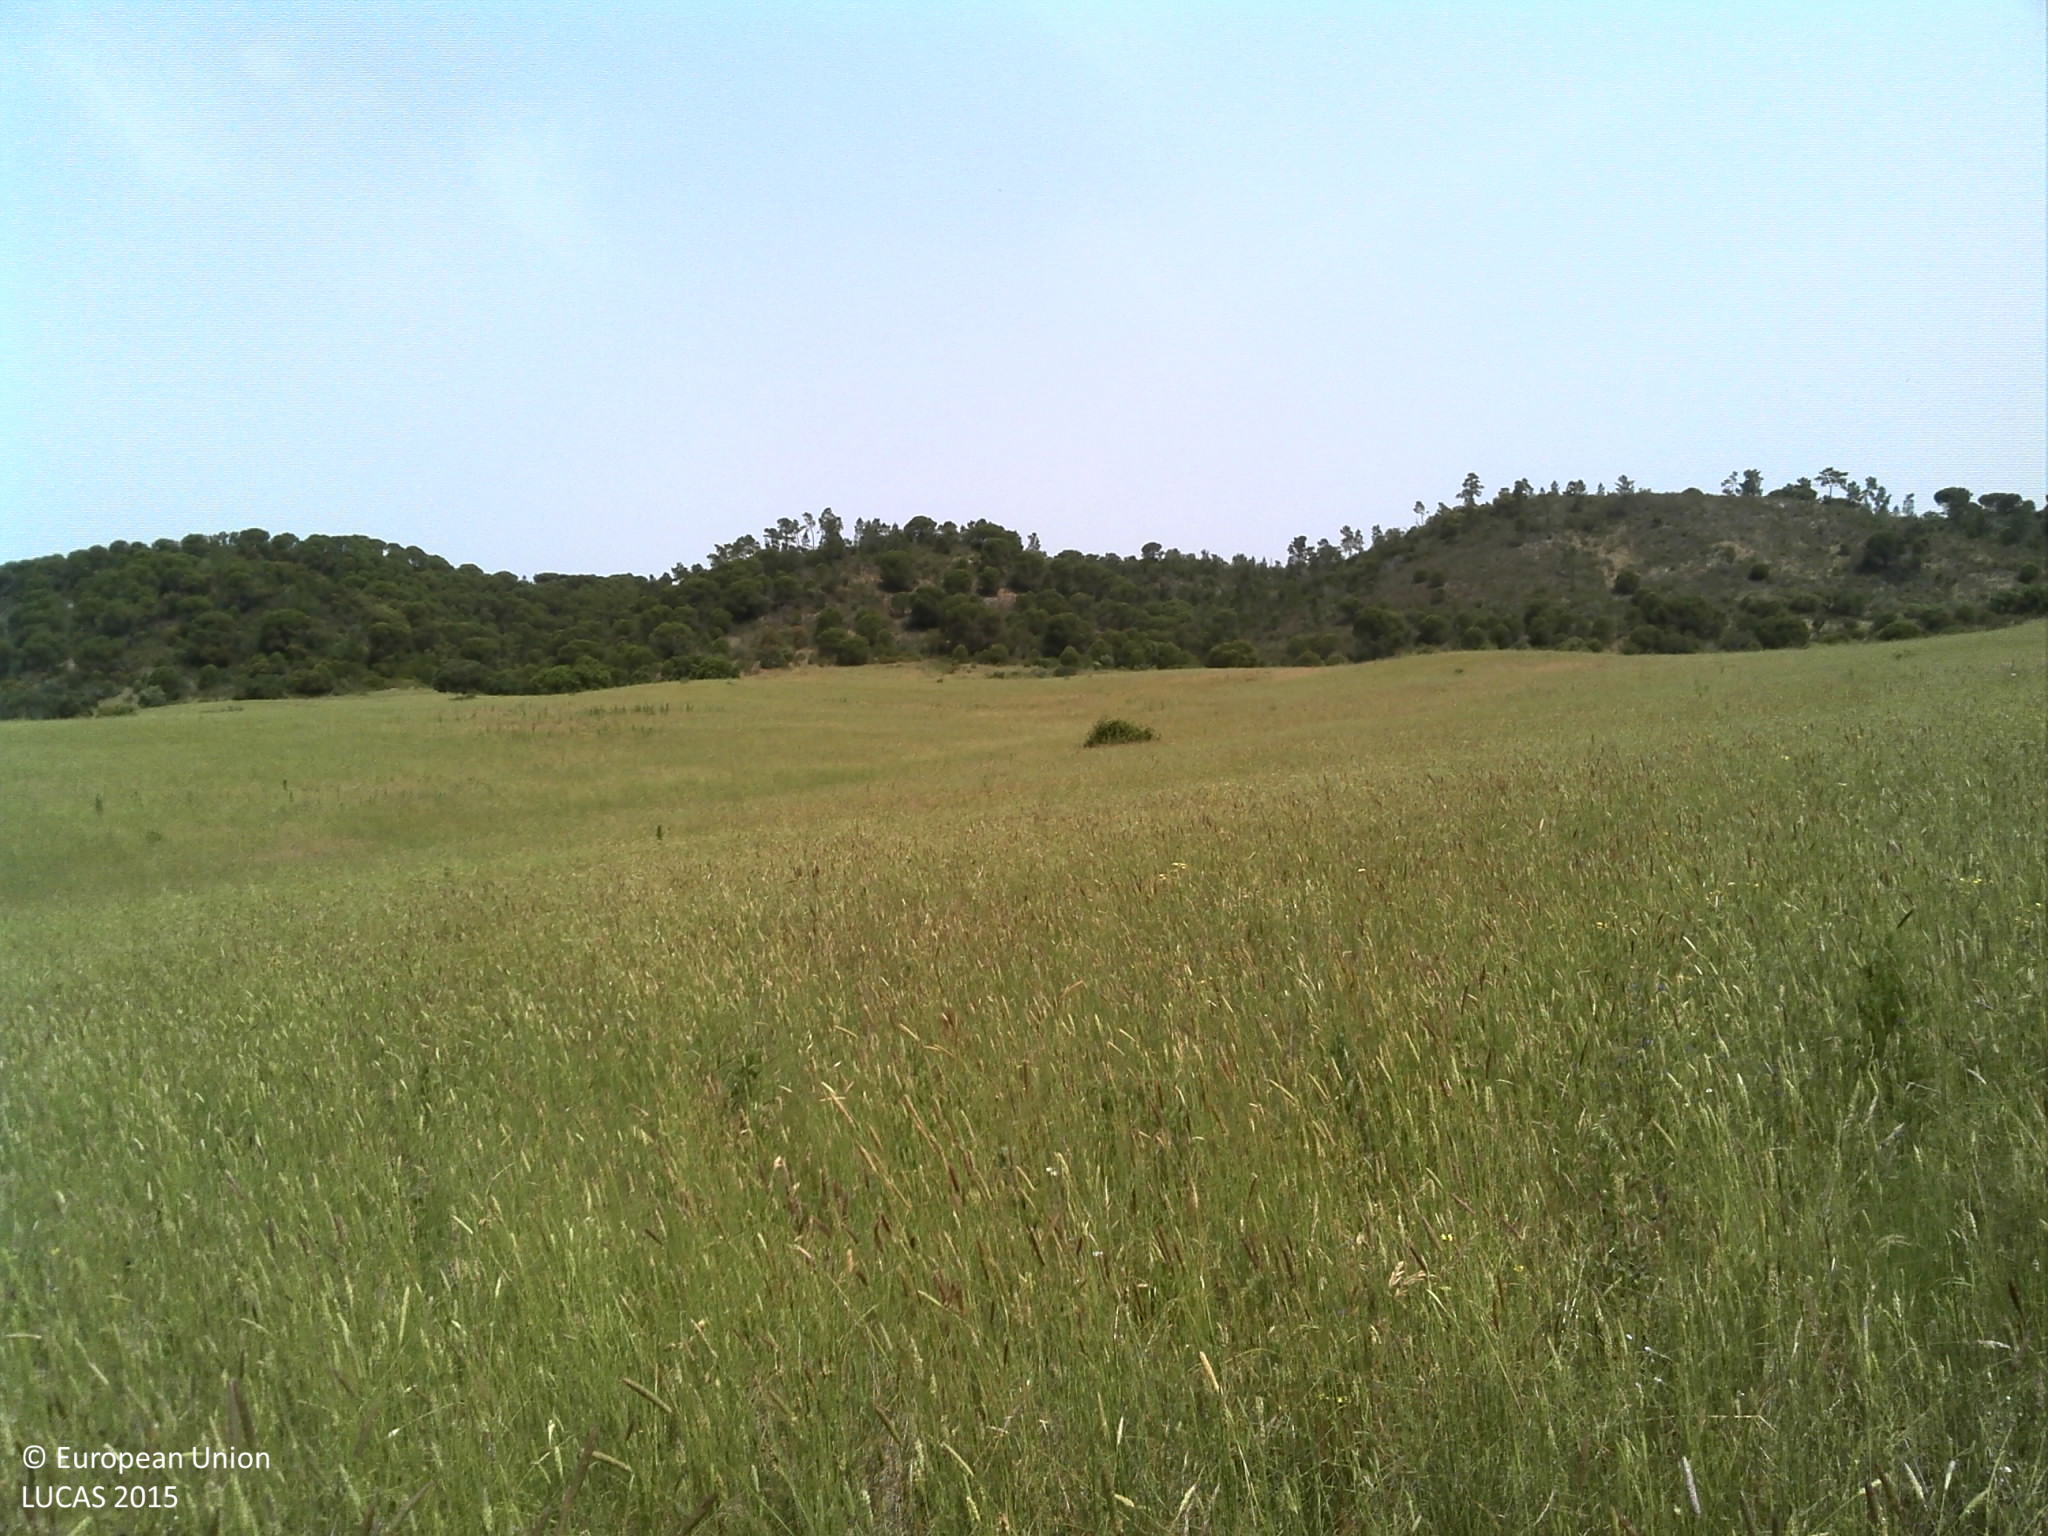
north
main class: Grassland
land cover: Spontaneously vegetated surfaces
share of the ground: > 75 %
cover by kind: herbaceous plants 75 %, unconsolidated bare surface 25 %
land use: Agriculture (excluding fallow land and kitchen gardens)
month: May
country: PT
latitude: 38.4642
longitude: -8.4453
